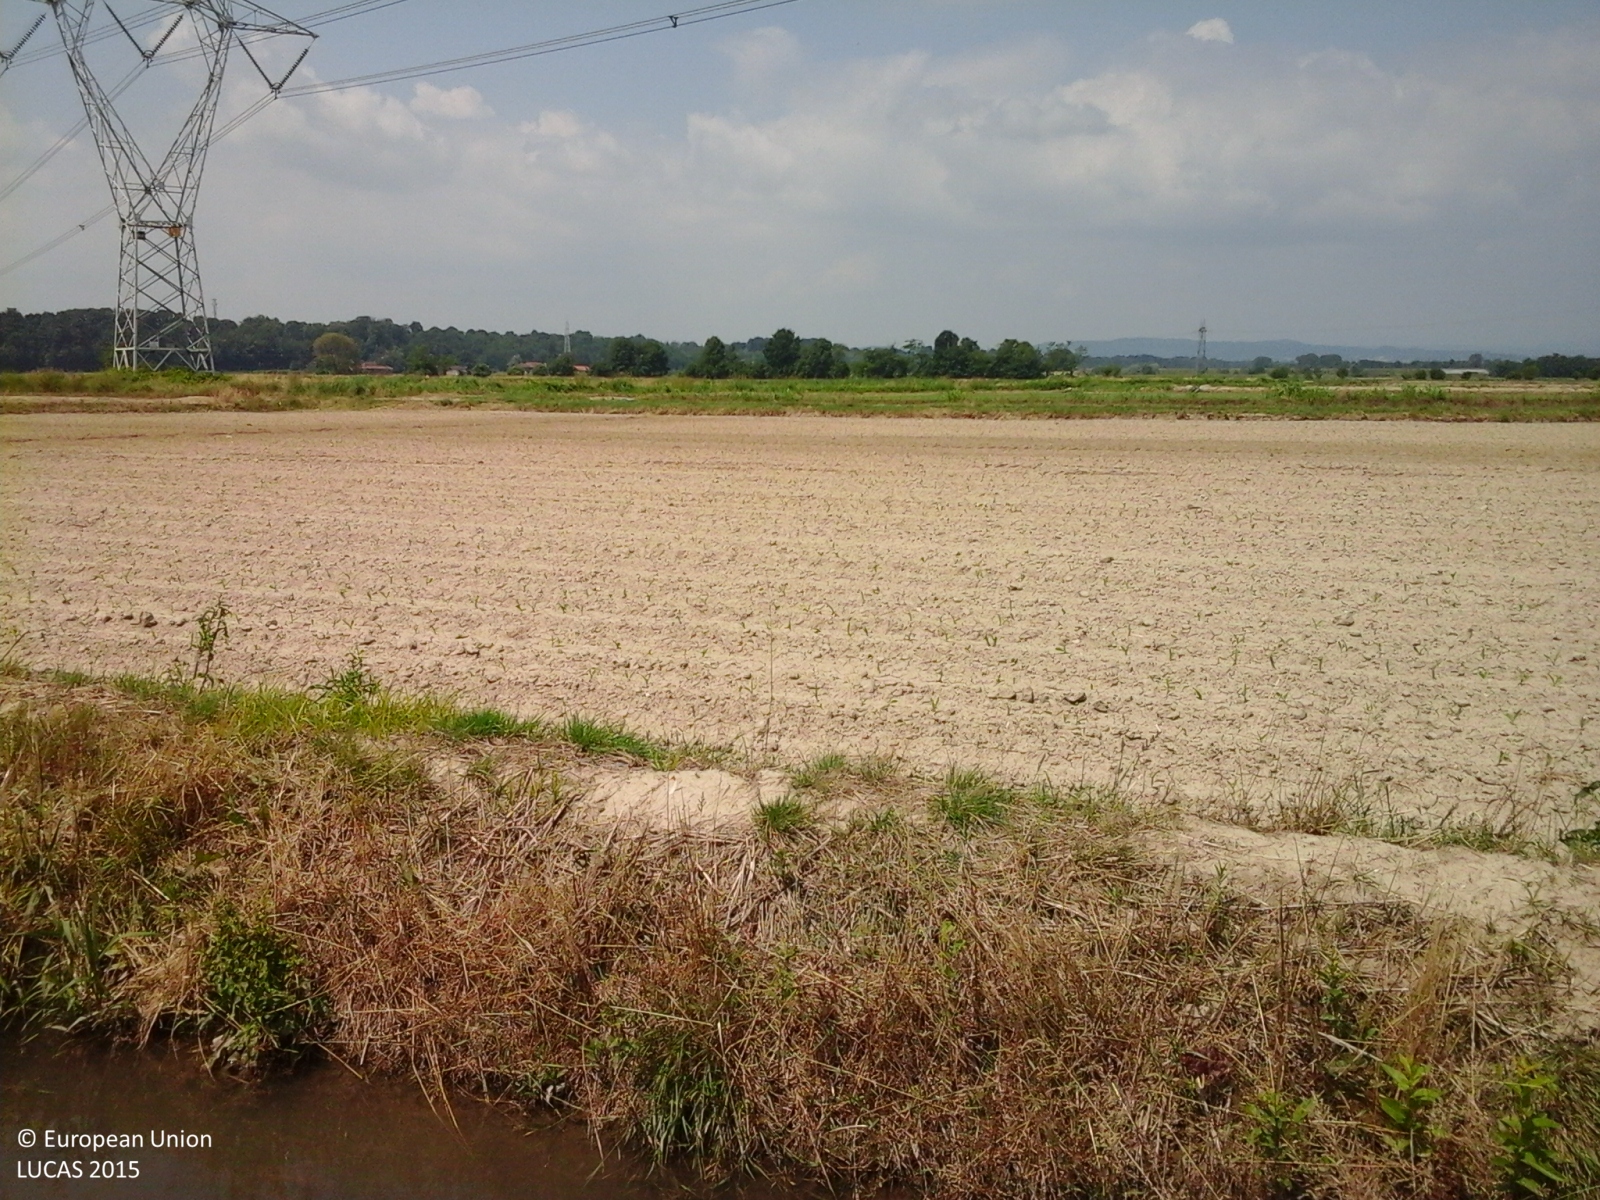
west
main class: Cropland
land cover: Rice
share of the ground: 25 - 50 %
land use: Agriculture (excluding fallow land and kitchen gardens)
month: May
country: IT
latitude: 45.4170
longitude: 8.2012
